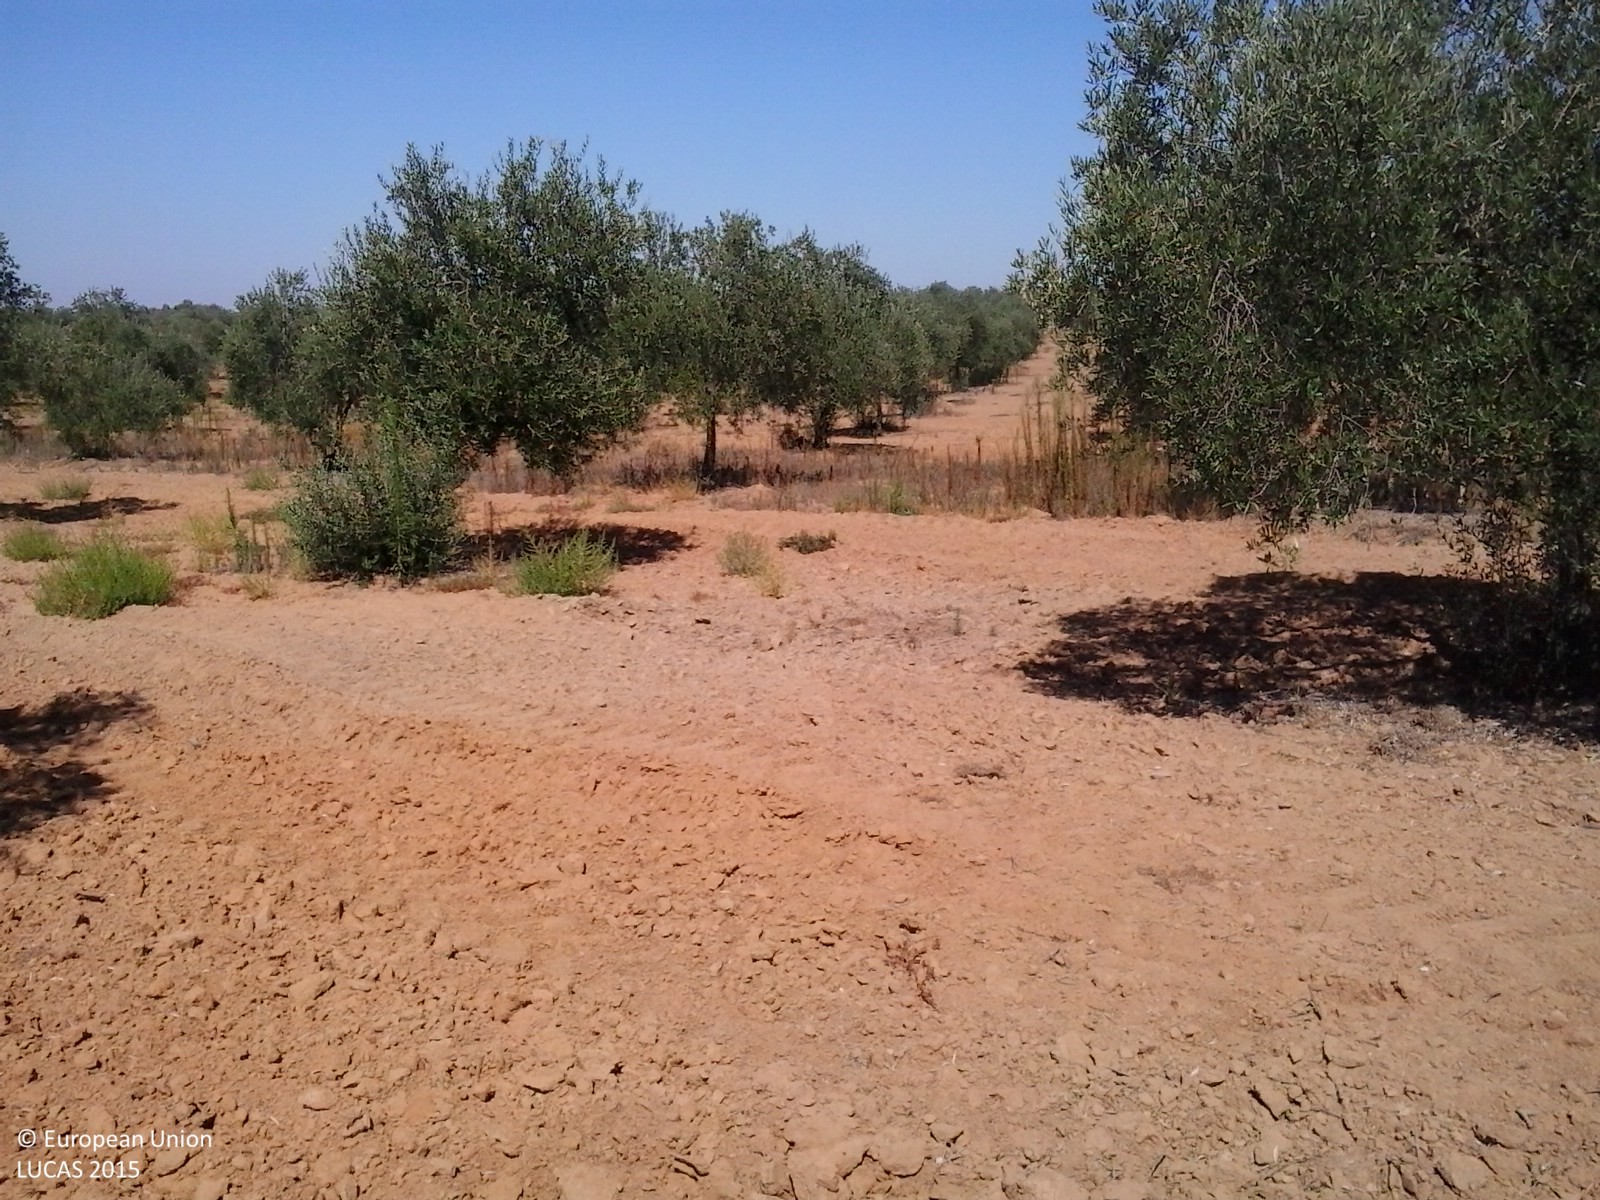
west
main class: Cropland
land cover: Olive groves
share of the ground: 10 - 25 %
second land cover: Other bare soil
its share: > 75 %
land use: Agriculture (excluding fallow land and kitchen gardens)
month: July
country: ES
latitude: 37.2604
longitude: -6.3659
